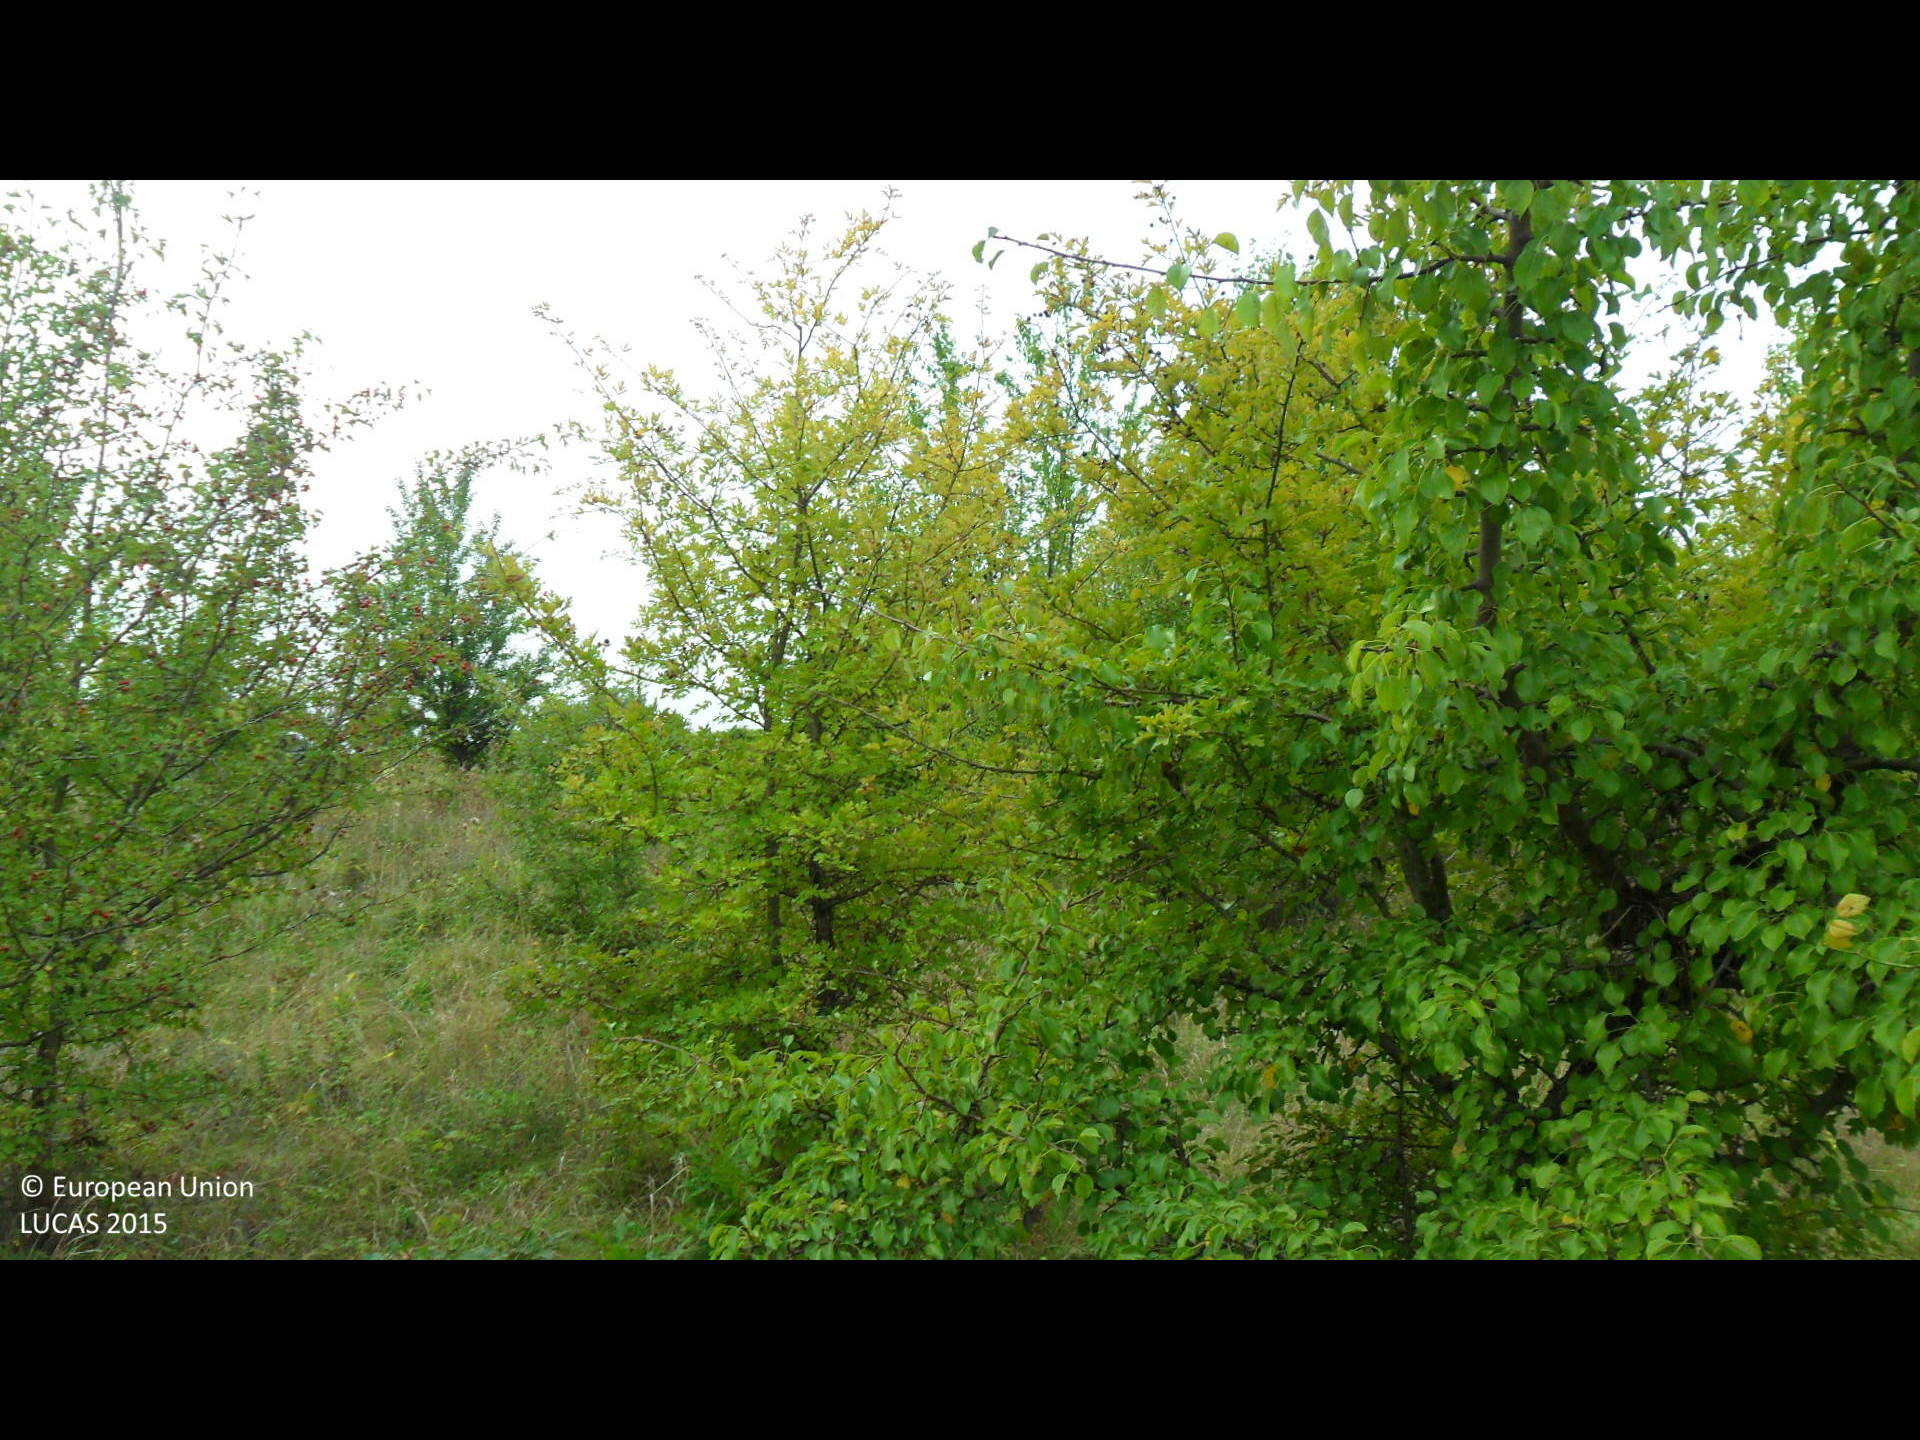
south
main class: Grassland
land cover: Grassland with sparse tree/shrub cover
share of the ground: > 75 %
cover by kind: herbaceous plants 90 %, broadleaved forest trees 5 %, shrubs 5 %
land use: Semi-natural and natural areas not in use
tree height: < 5 m
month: September
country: BG
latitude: 43.2676
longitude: 26.0964
